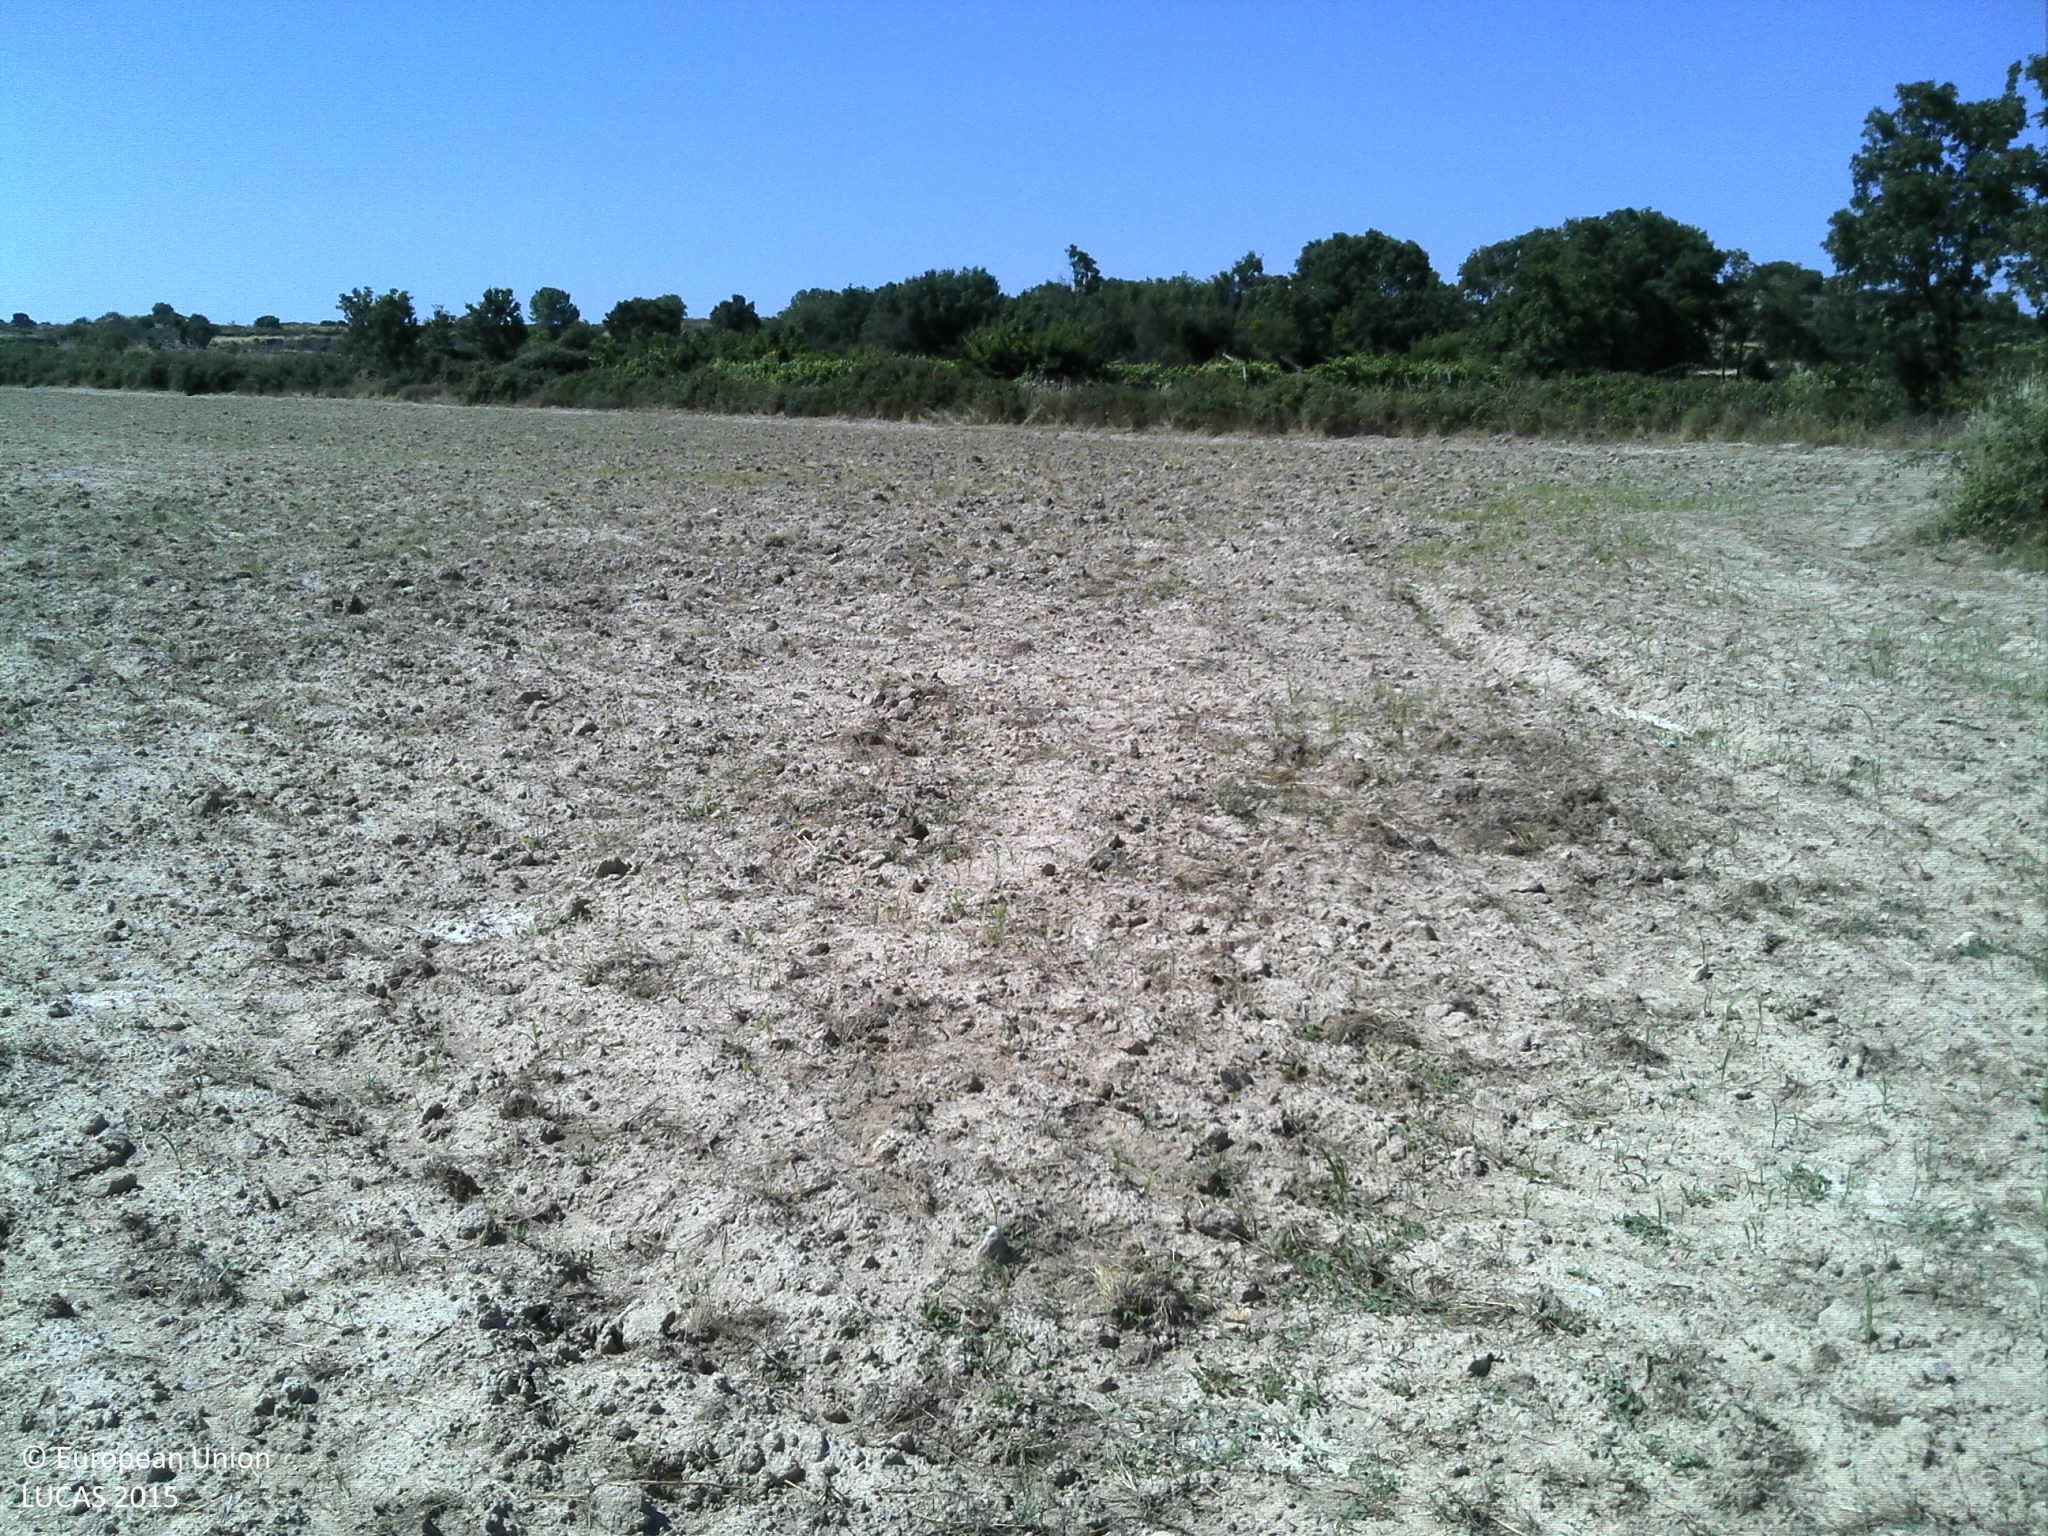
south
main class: Cropland
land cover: Durum wheat
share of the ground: < 10 %
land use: Agriculture (excluding fallow land and kitchen gardens)
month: June
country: PT
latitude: 40.9611
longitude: -6.9166
